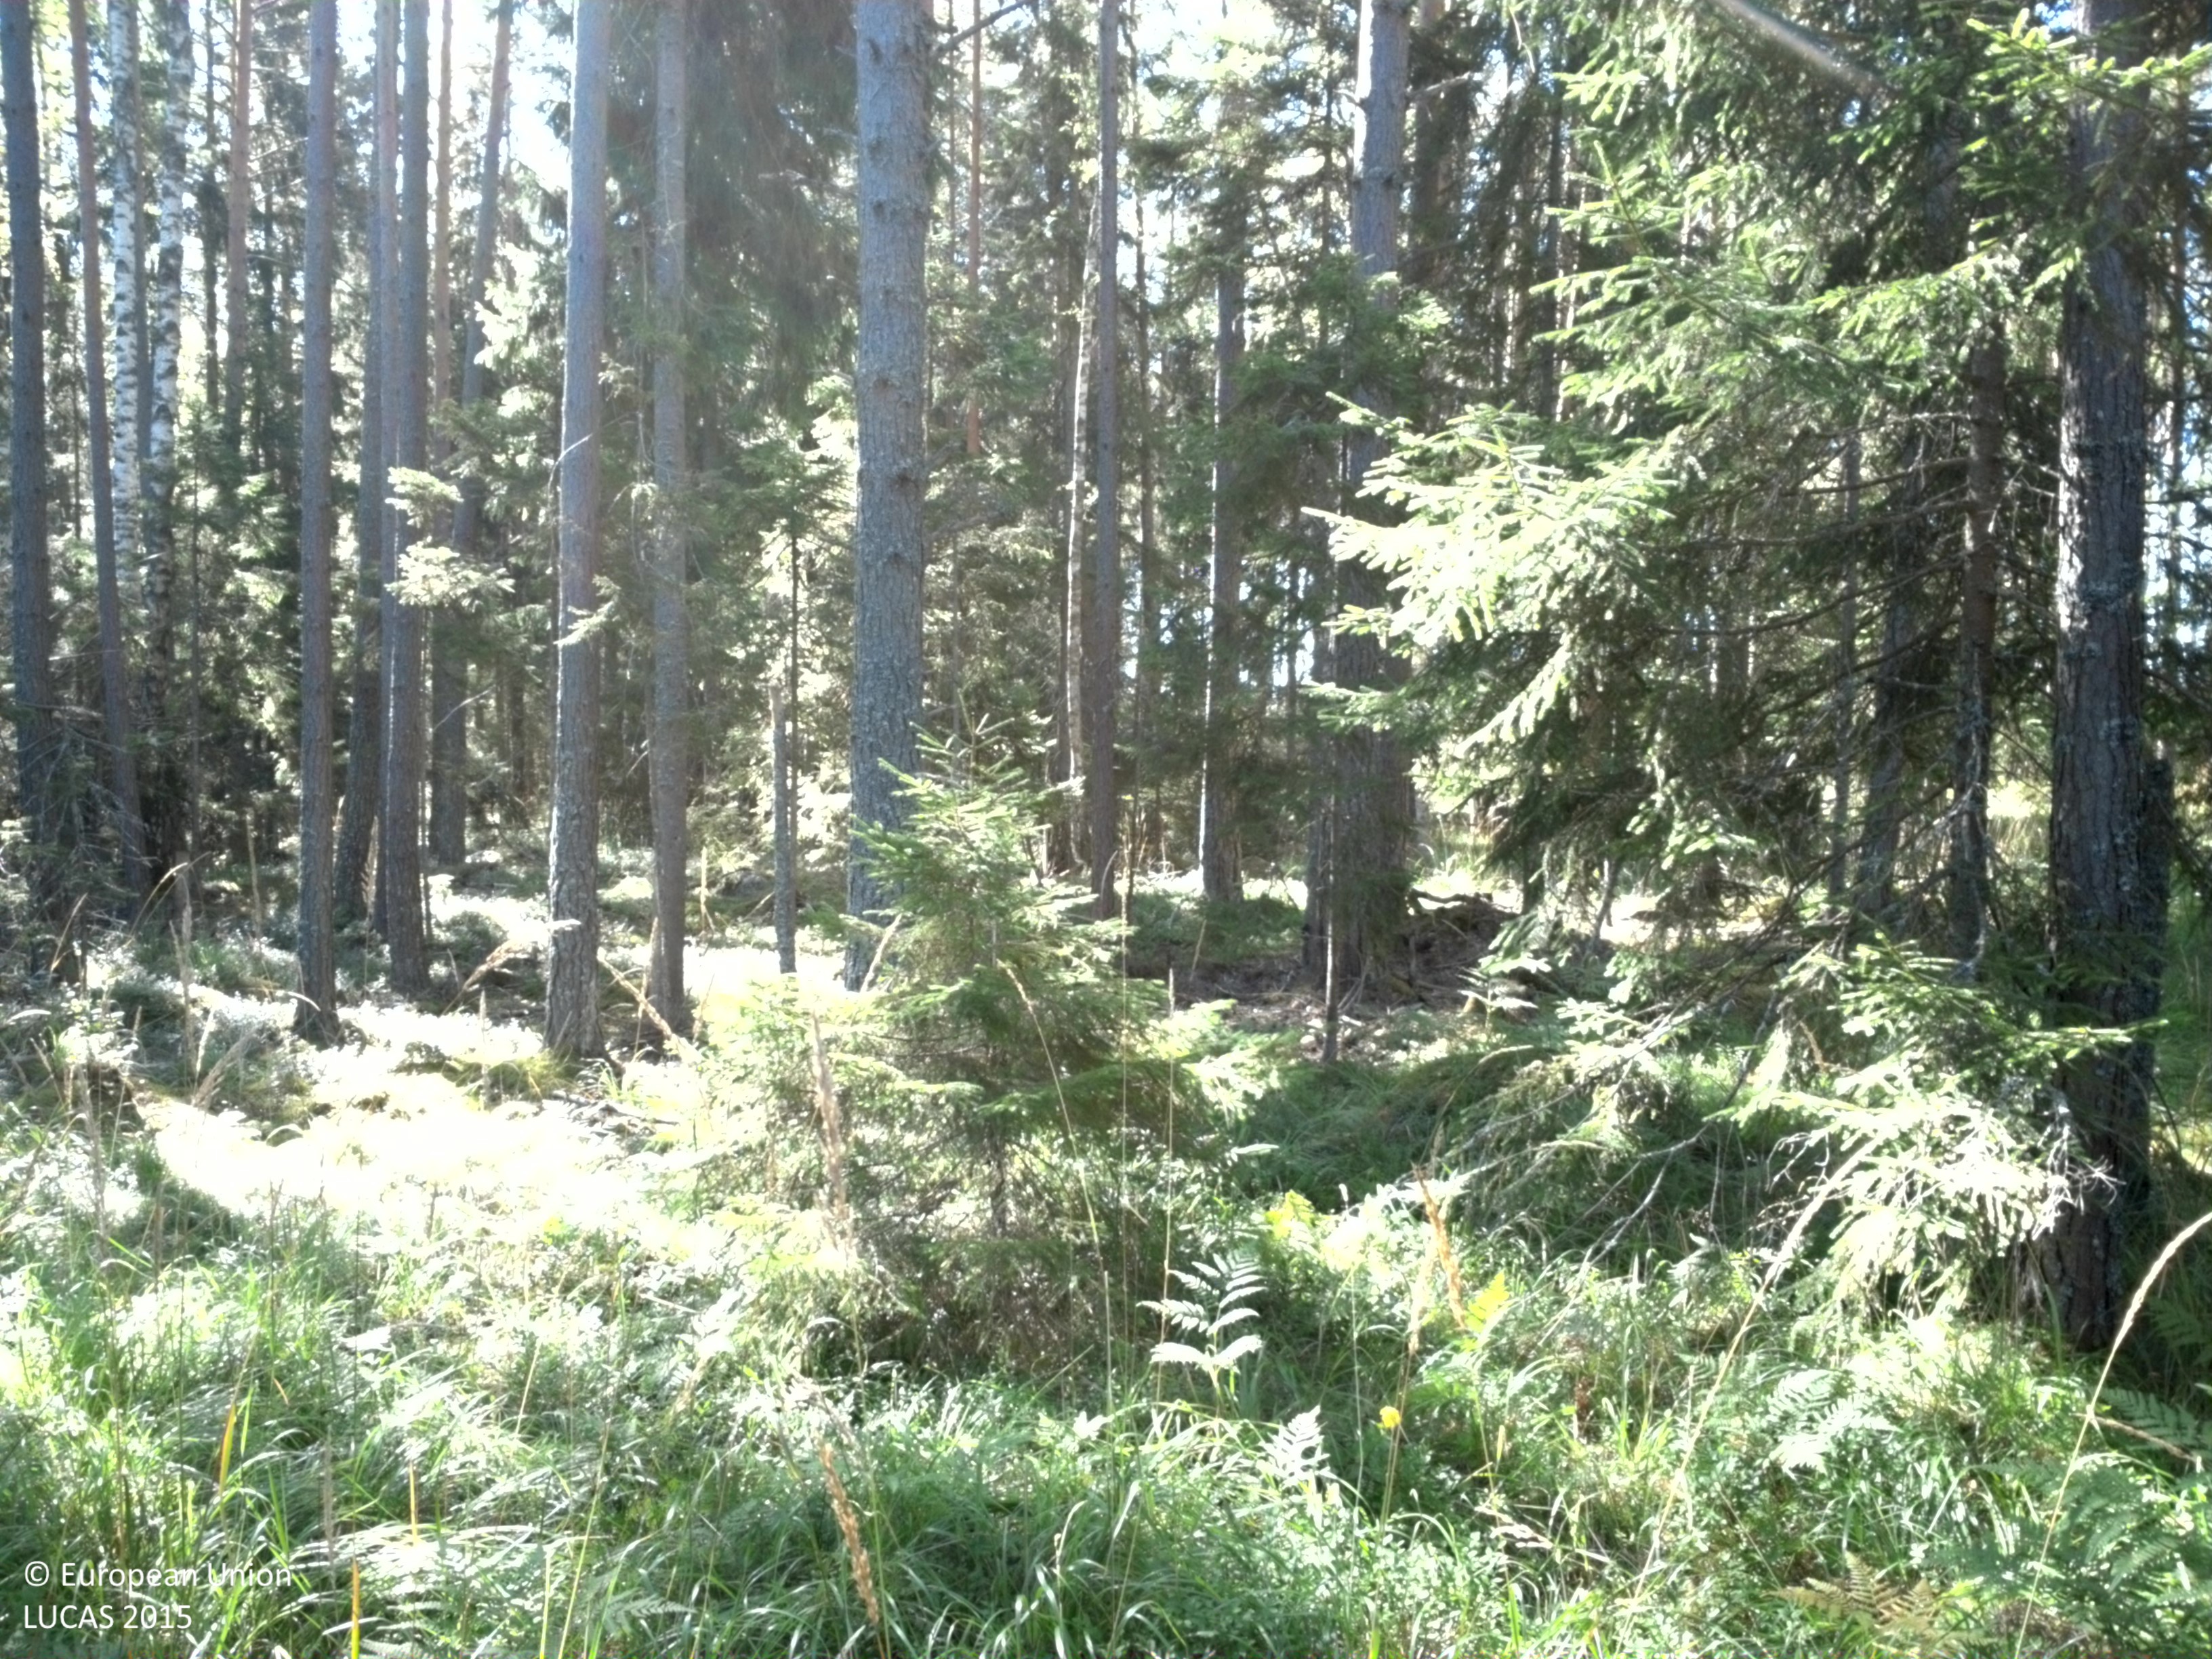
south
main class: Woodland
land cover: Pine dominated coniferous woodland
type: boreal forest
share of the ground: 50 - 75 %
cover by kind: coniferous forest trees 55 %, herbaceous plants 30 %, broadleaved forest trees 5 %, shrubs 5 %, lichens and mosses 5 %
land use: Forestry
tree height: > 5 m
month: August
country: SE
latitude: 60.0785
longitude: 18.0287
